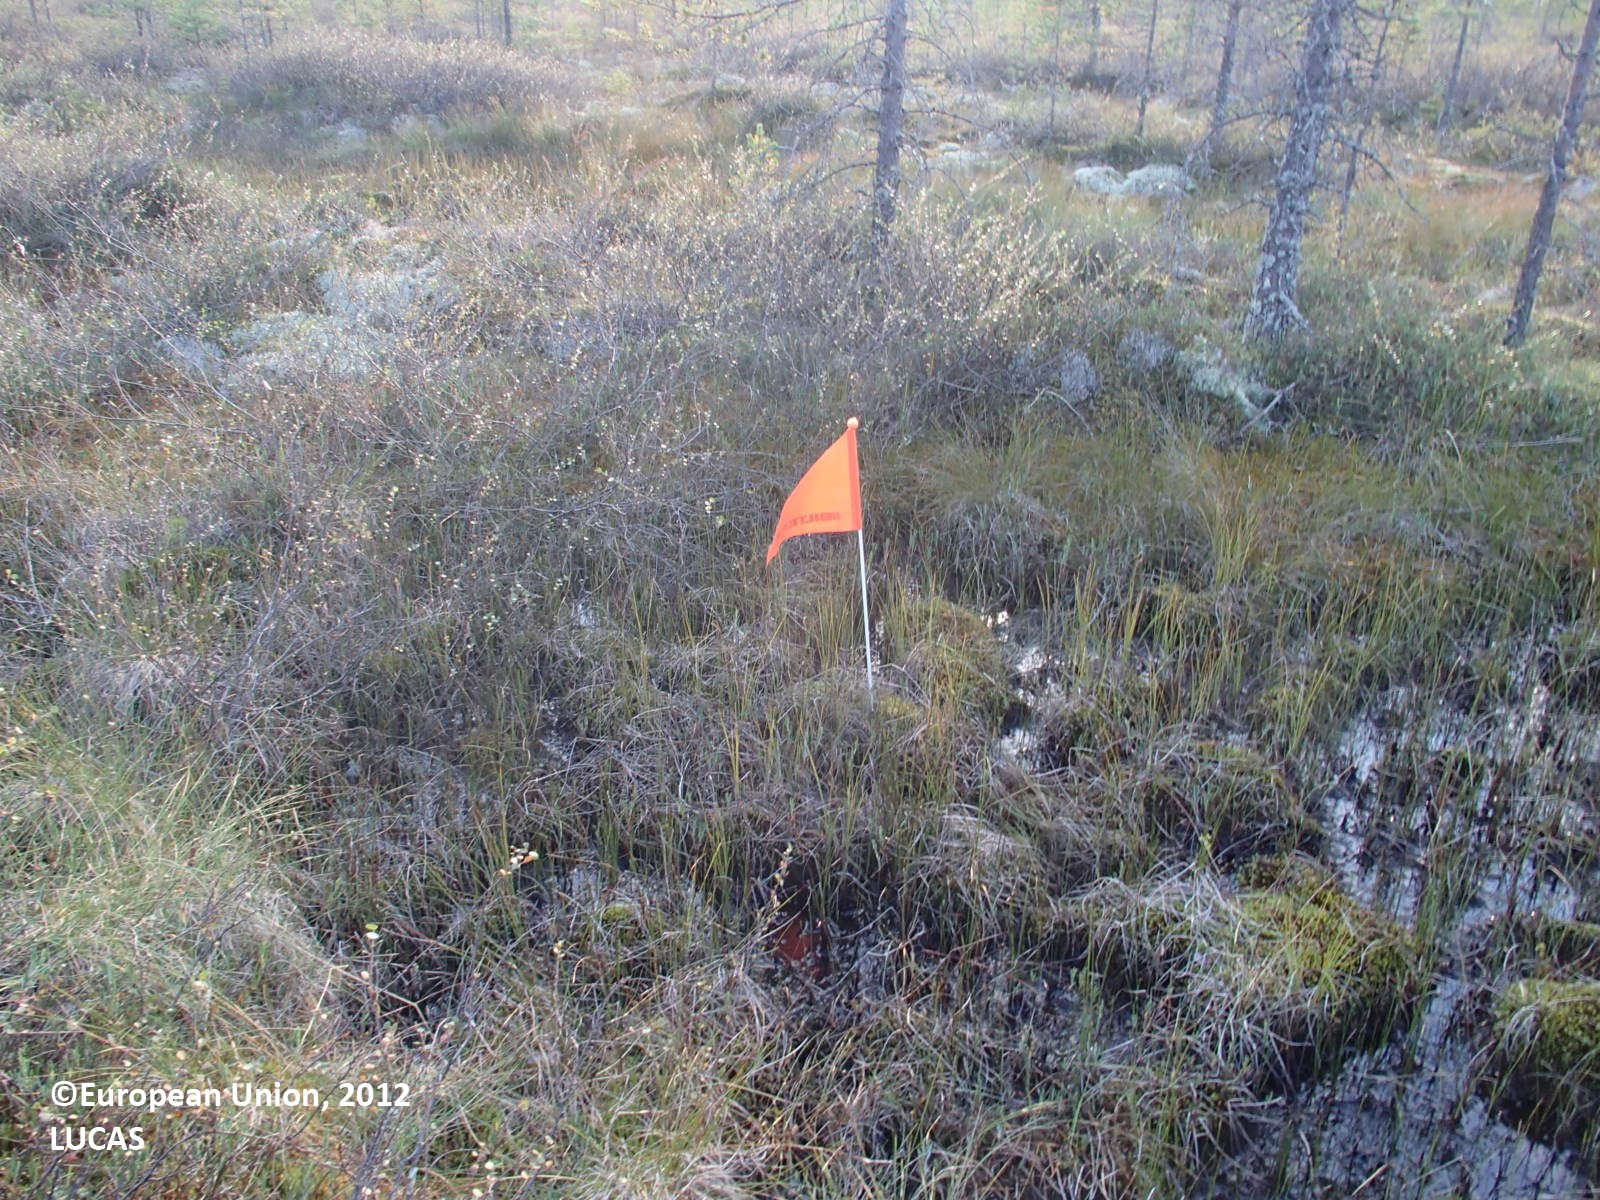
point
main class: Woodland
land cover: Pine dominated coniferous woodland
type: boreal forest
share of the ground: 25 - 50 %
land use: Forestry
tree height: < 5 m
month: August
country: FI
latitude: 63.9438
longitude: 26.0458
